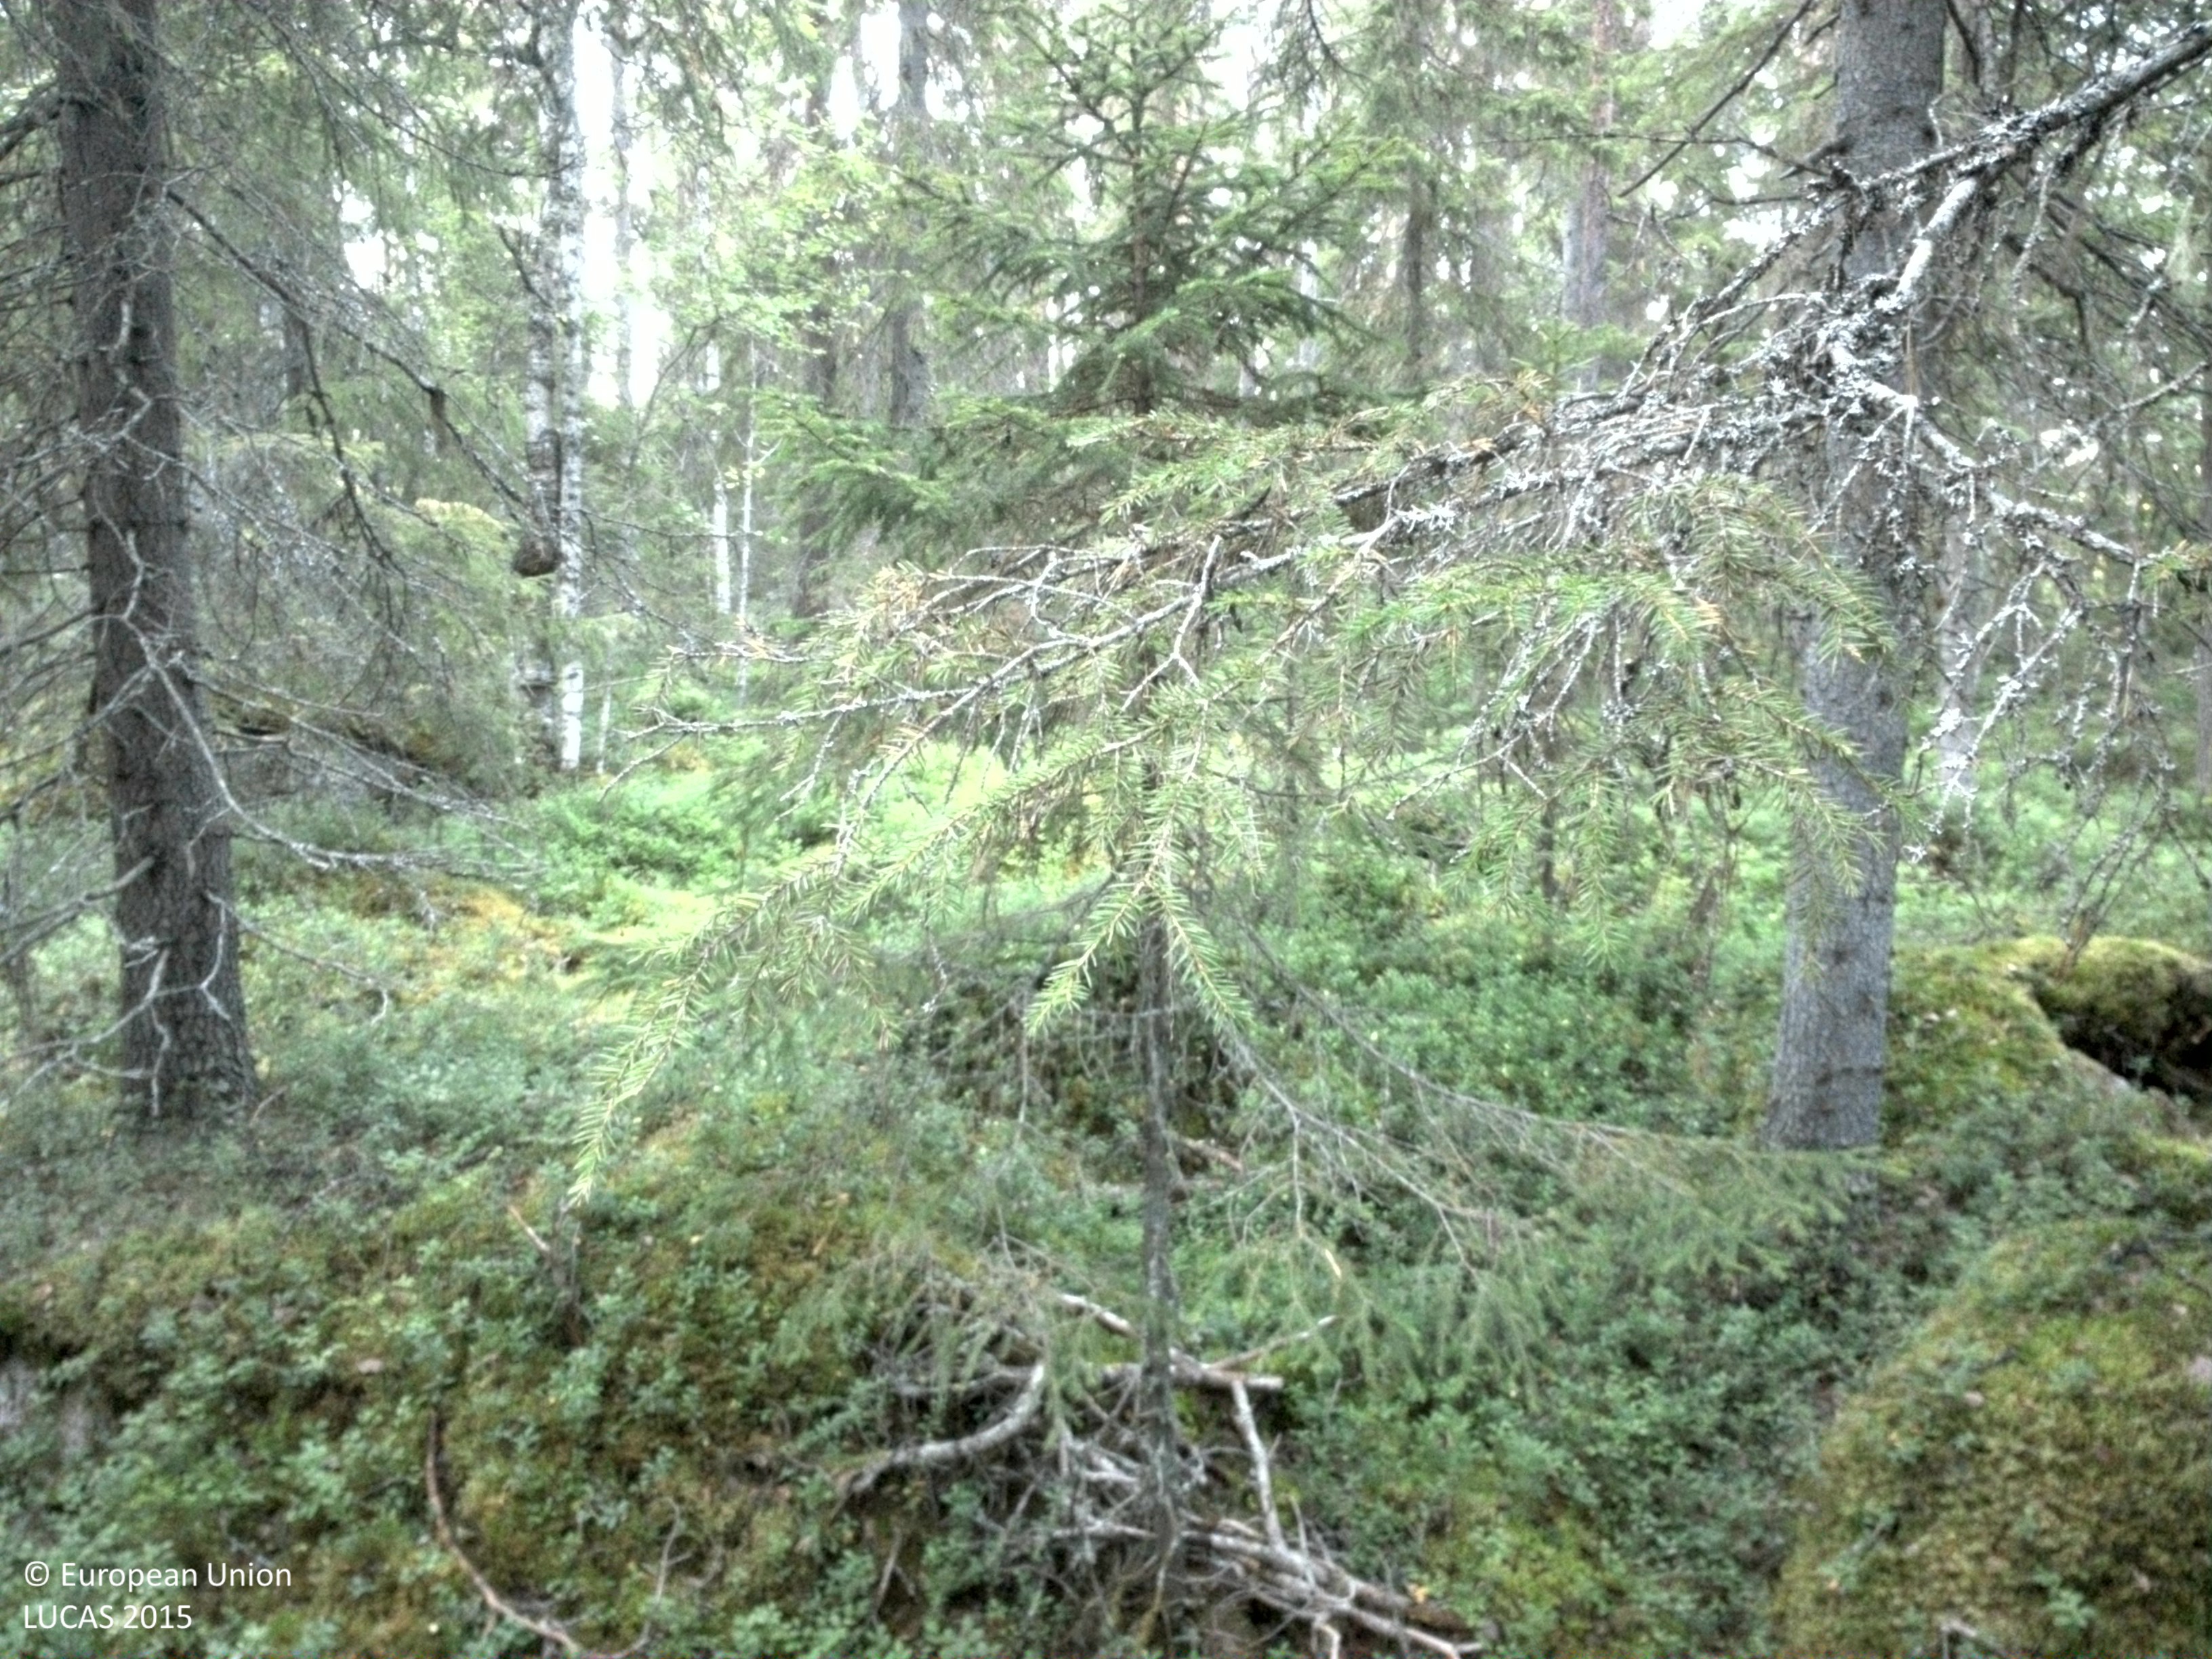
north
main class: Woodland
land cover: Other coniferous woodland
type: boreal forest
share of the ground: 50 - 75 %
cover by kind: coniferous forest trees 50 %, shrubs 25 %, lichens and mosses 15 %, broadleaved forest trees 10 %
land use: Forestry
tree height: > 5 m
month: August
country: SE
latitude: 64.5449
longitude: 16.7444
